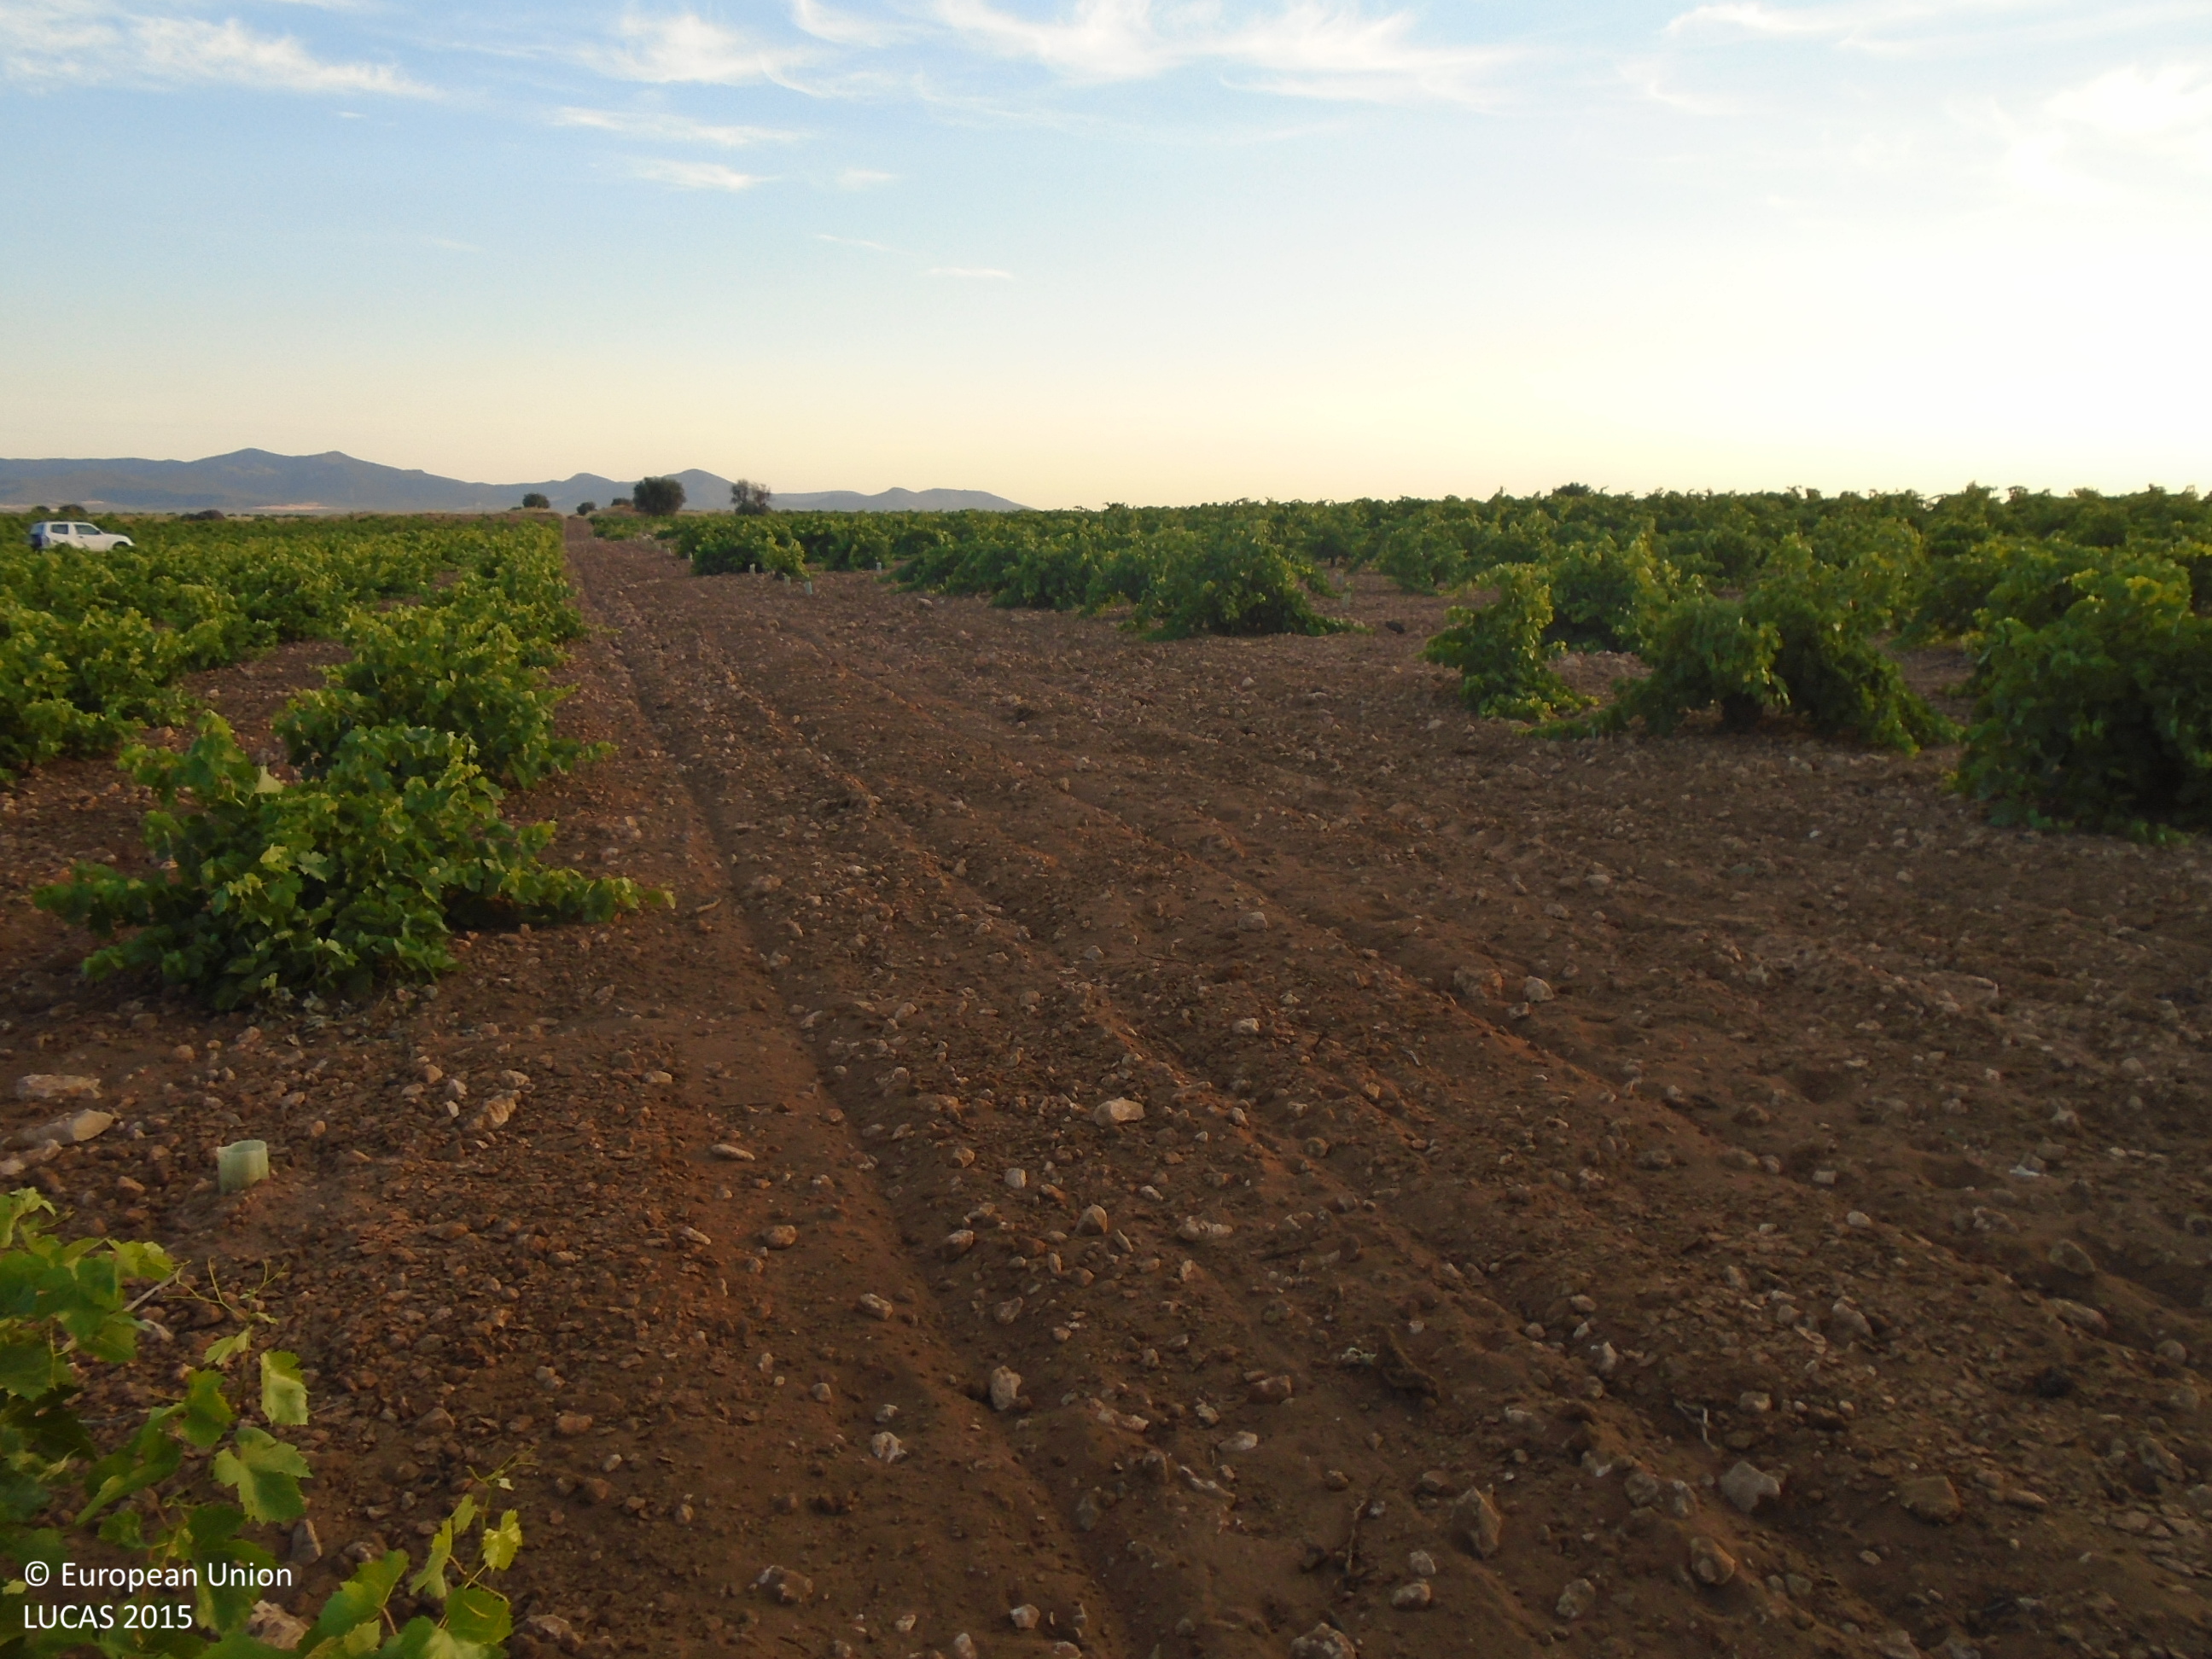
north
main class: Cropland
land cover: Vineyards
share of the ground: 50 - 75 %
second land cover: Other bare soil
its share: > 75 %
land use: Agriculture (excluding fallow land and kitchen gardens)
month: June
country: ES
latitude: 39.2001
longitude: -3.5085
